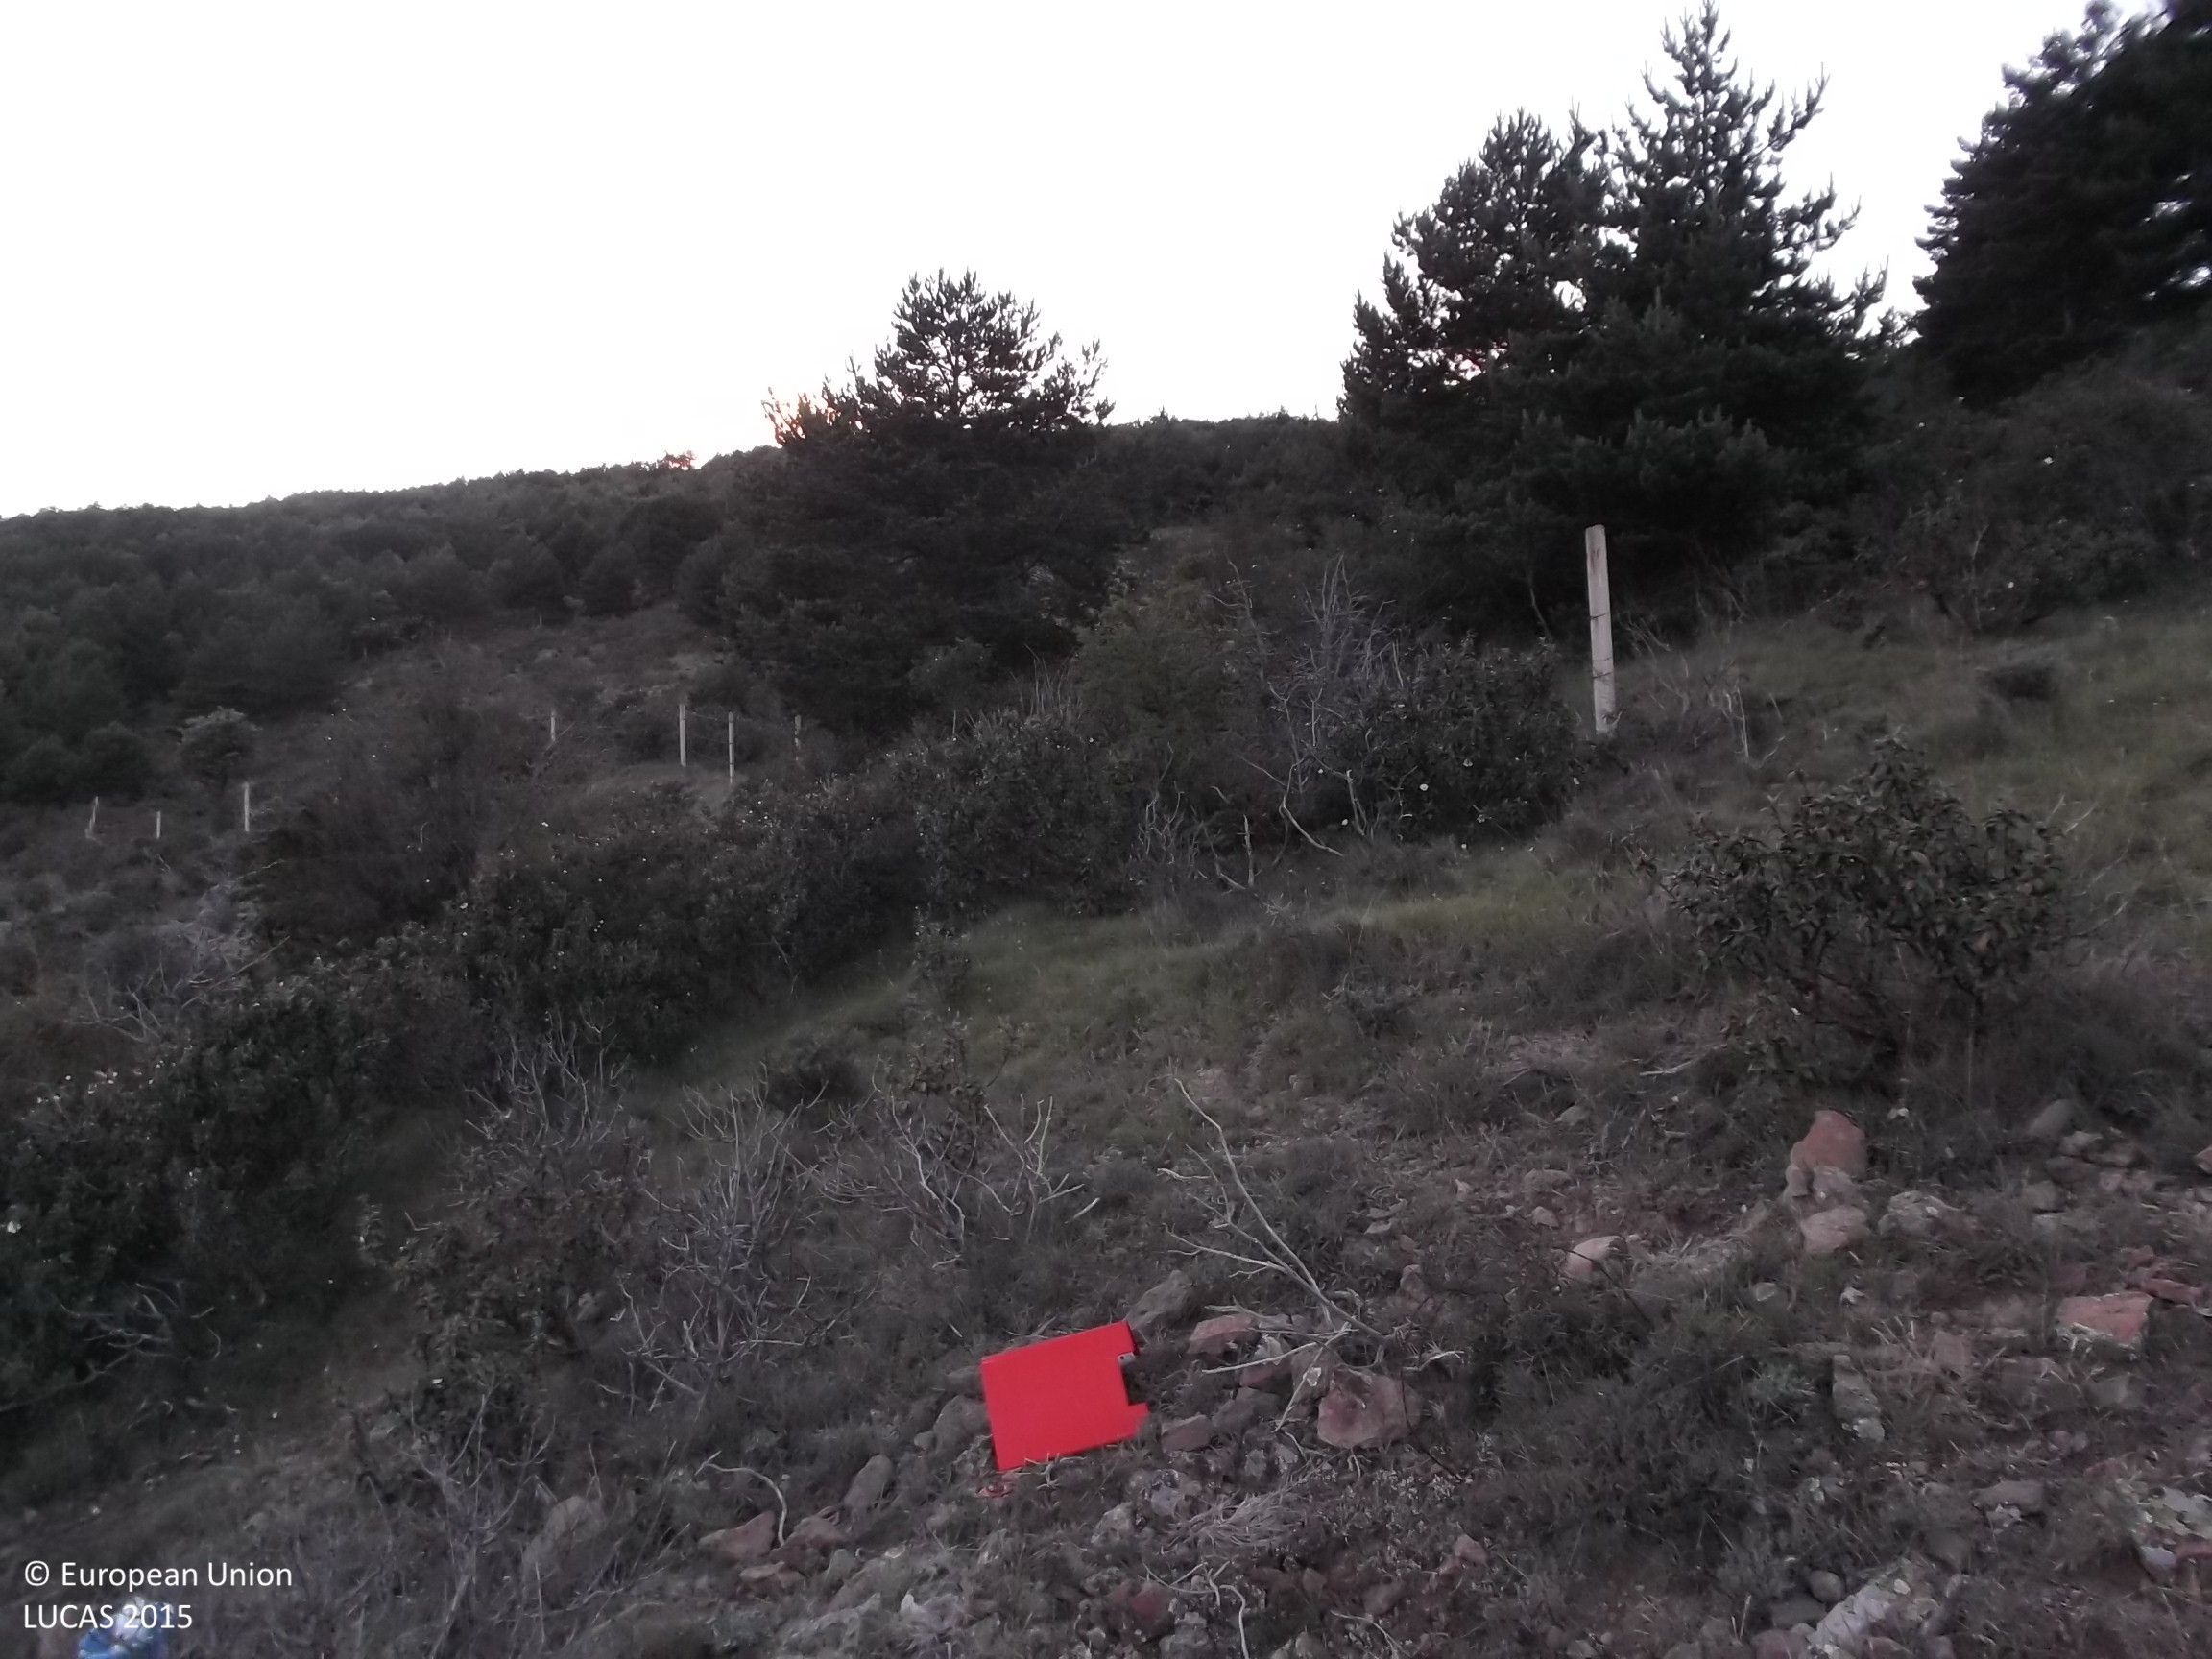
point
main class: Shrubland
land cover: Shrubland with sparse tree cover
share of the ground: 50 - 75 %
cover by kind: shrubs 60 %, herbaceous plants 20 %, unconsolidated bare surface 15 %, broadleaved forest trees 5 %
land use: Semi-natural and natural areas not in use
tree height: < 5 m
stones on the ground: > 50 %
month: June
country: ES
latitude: 42.1360
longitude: -2.3201
